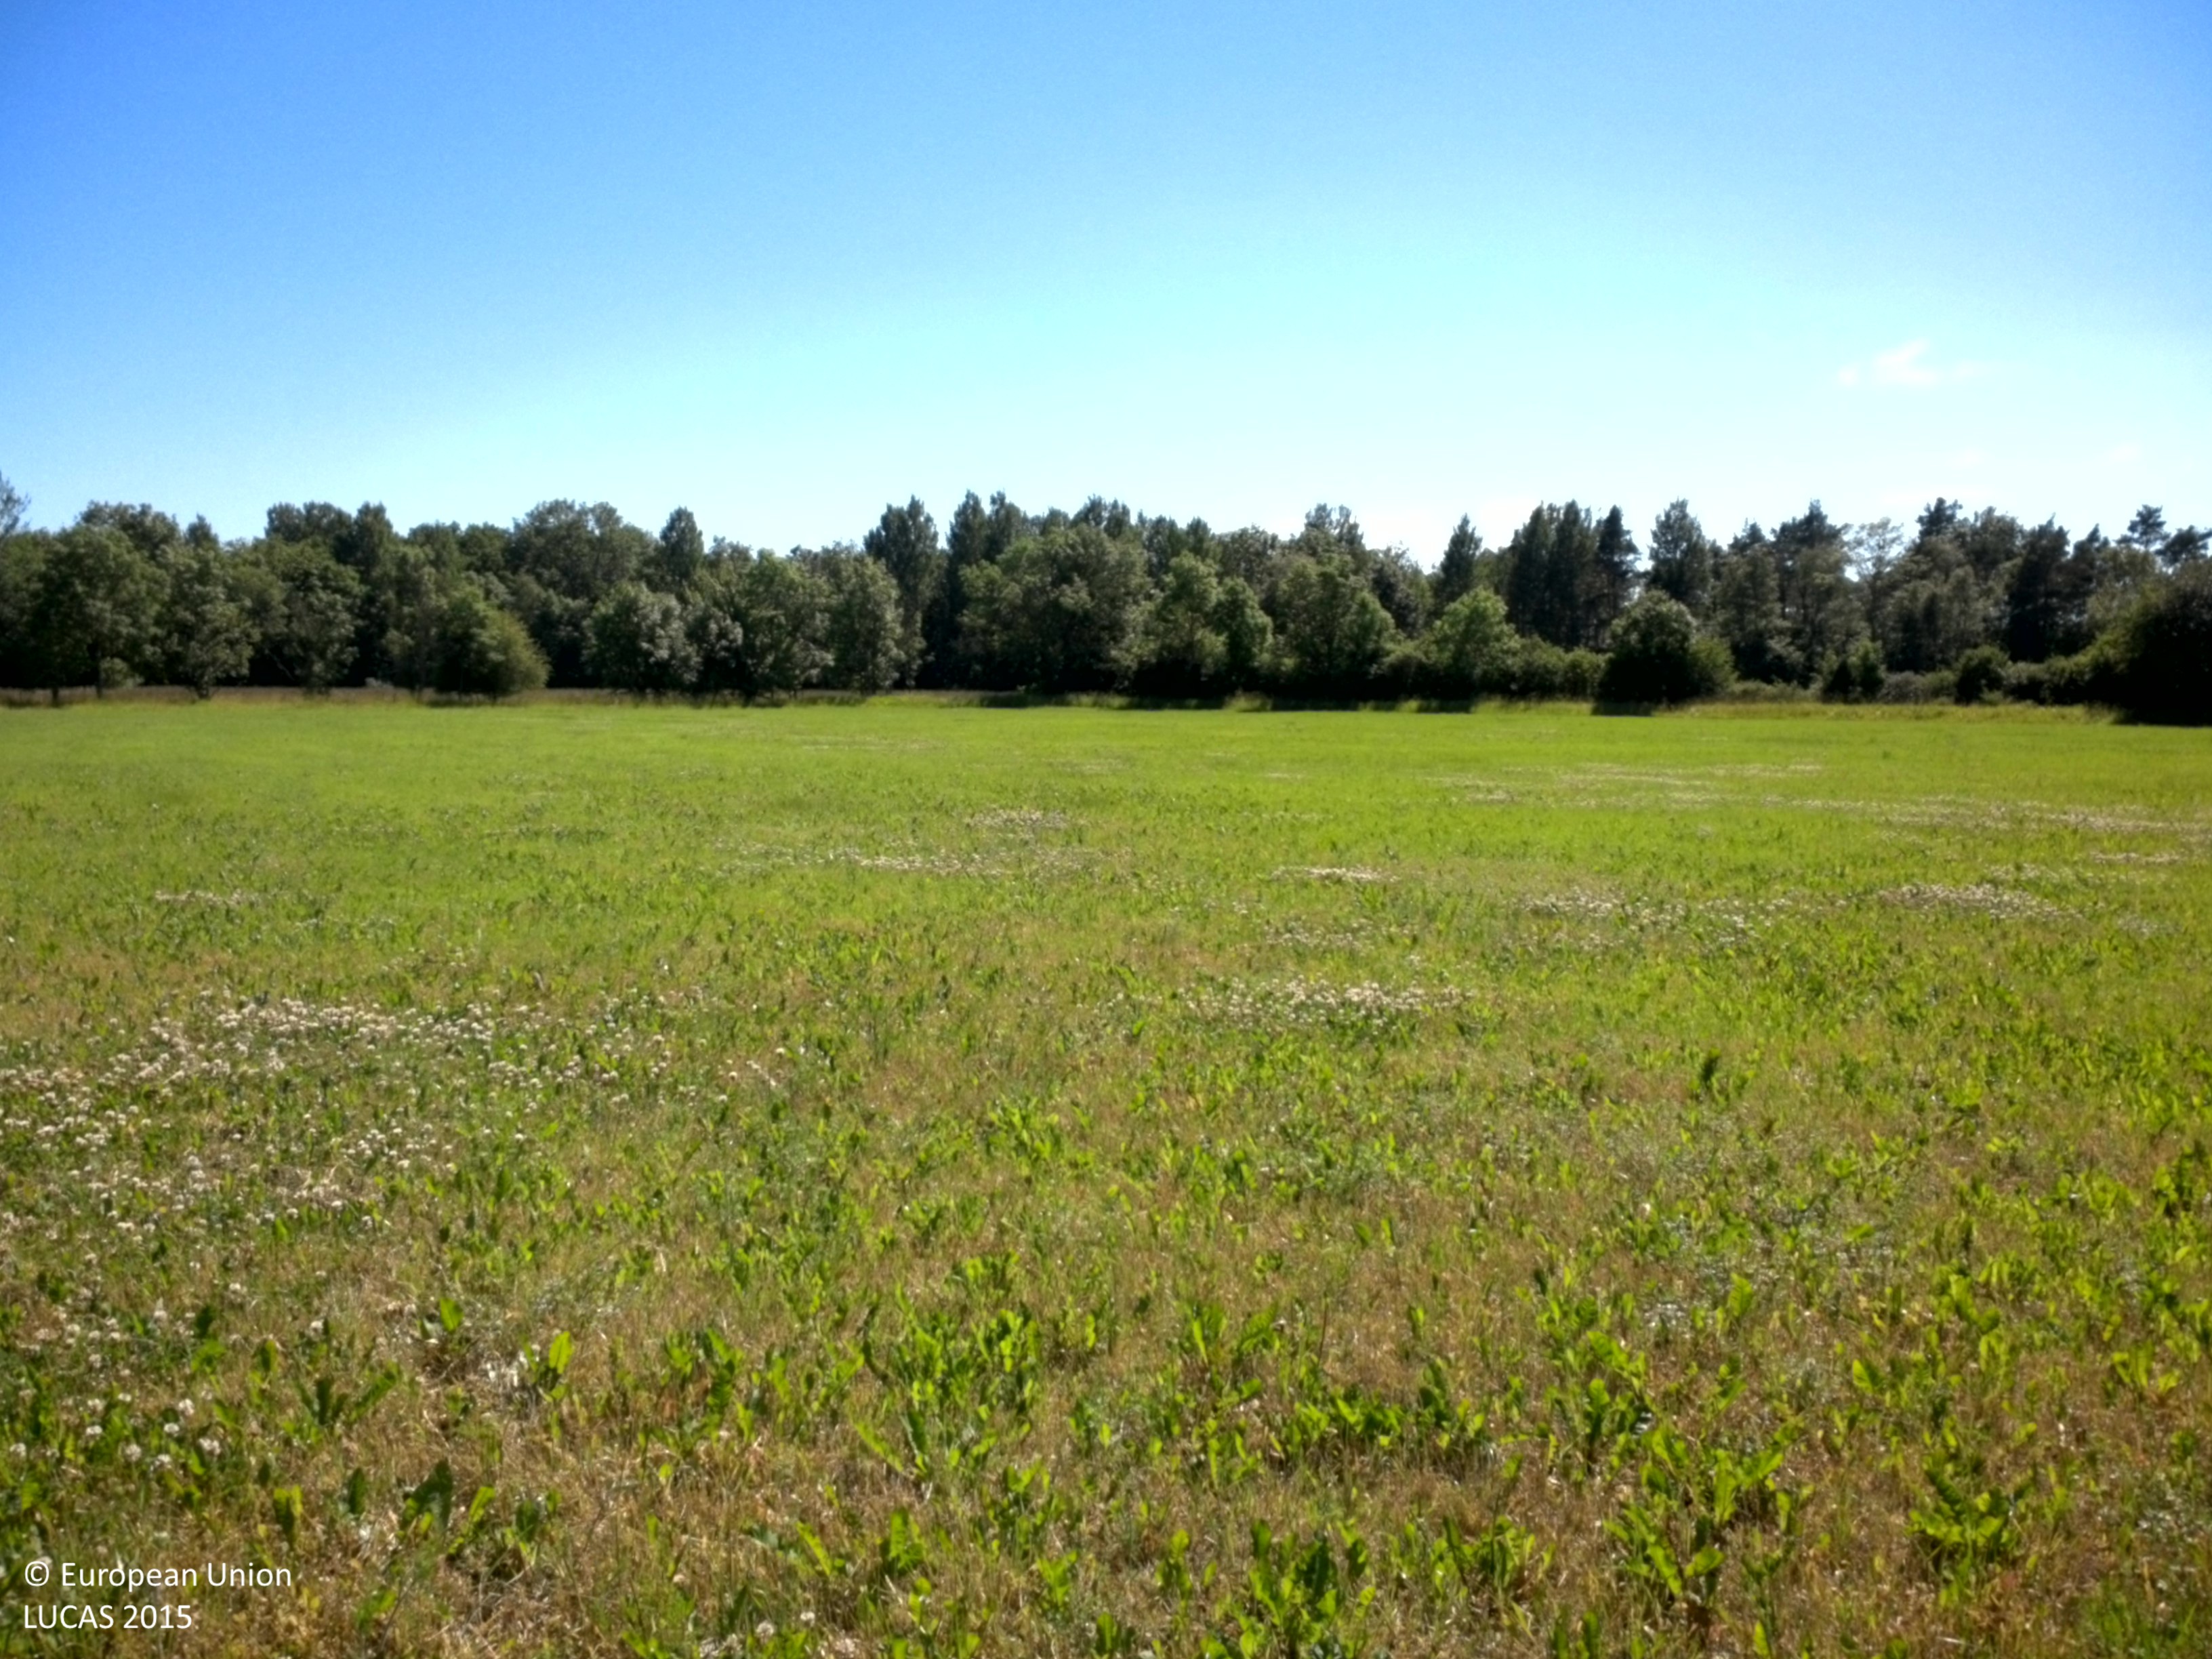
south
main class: Grassland
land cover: Grassland without tree/shrub cover
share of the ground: > 75 %
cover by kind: herbaceous plants 100 %
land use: Agriculture (excluding fallow land and kitchen gardens)
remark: Harvested field
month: July
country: SE
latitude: 57.7809
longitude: 18.8725
